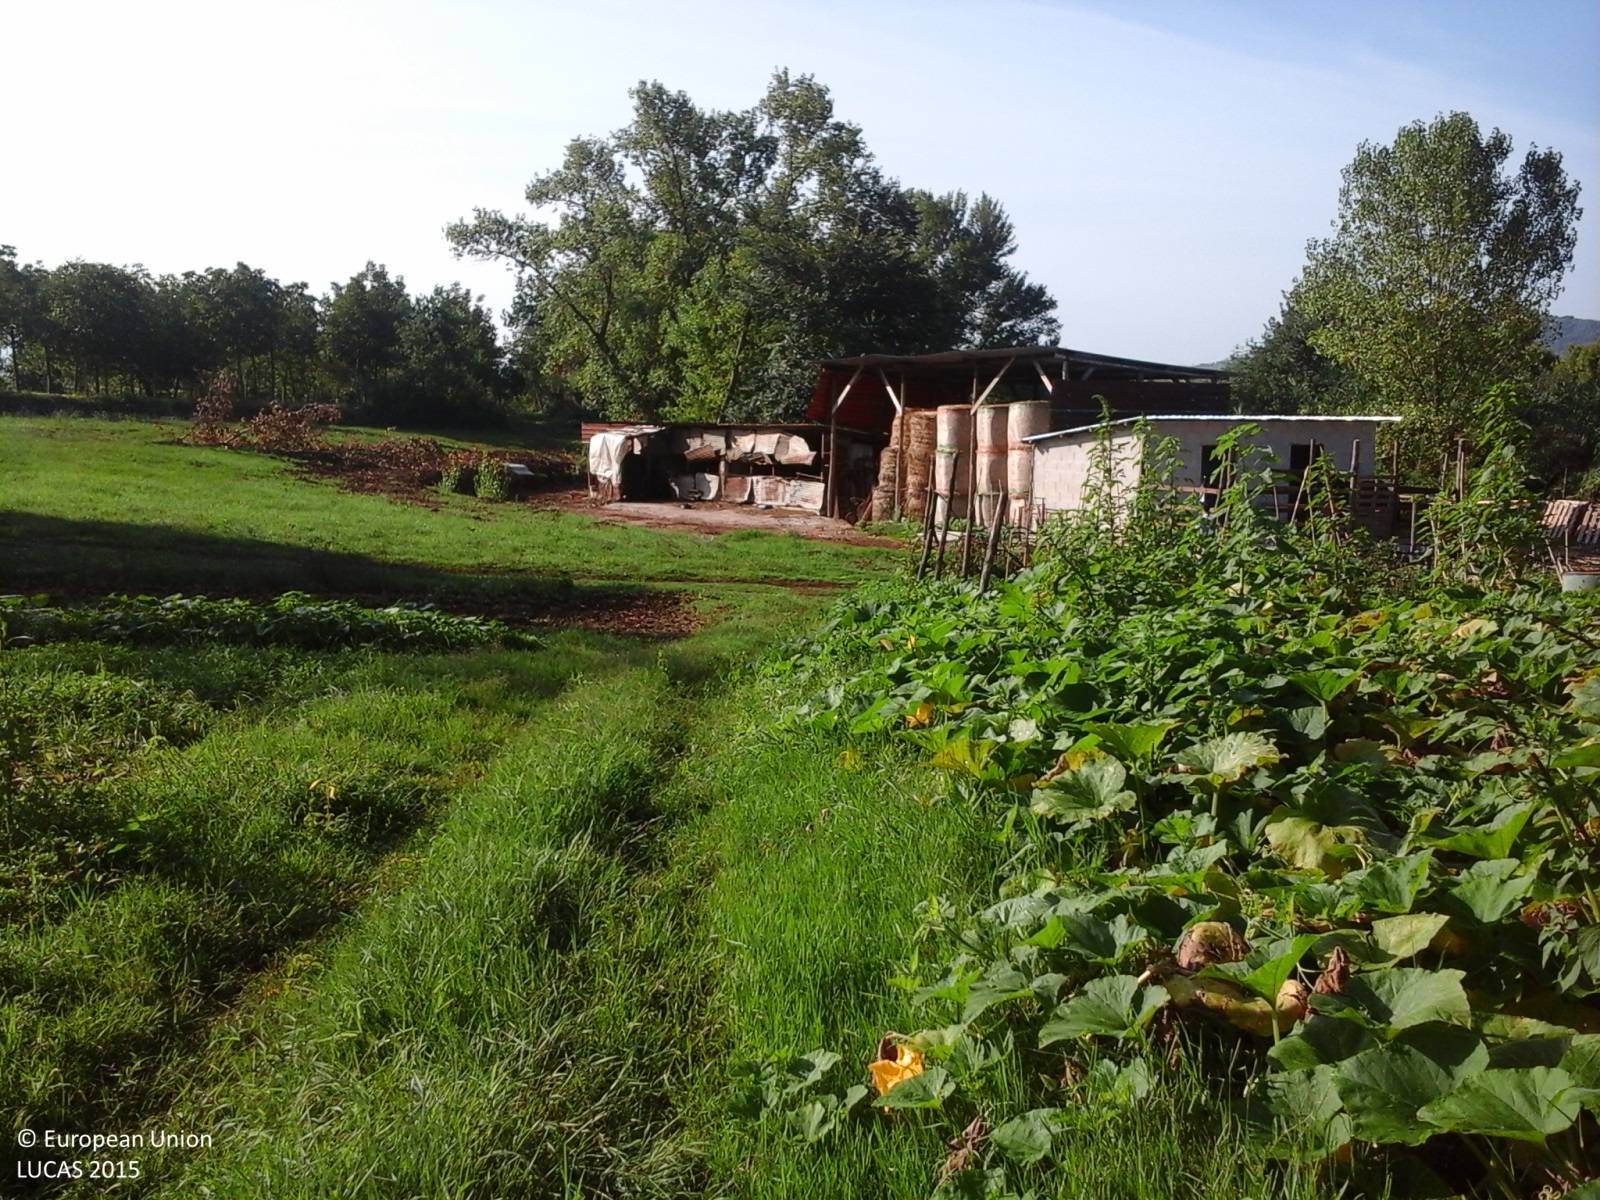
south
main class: Cropland
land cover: Other fresh vegetables
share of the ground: > 75 %
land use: Kitchen garden
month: August
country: IT
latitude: 41.5017
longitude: 13.1623
